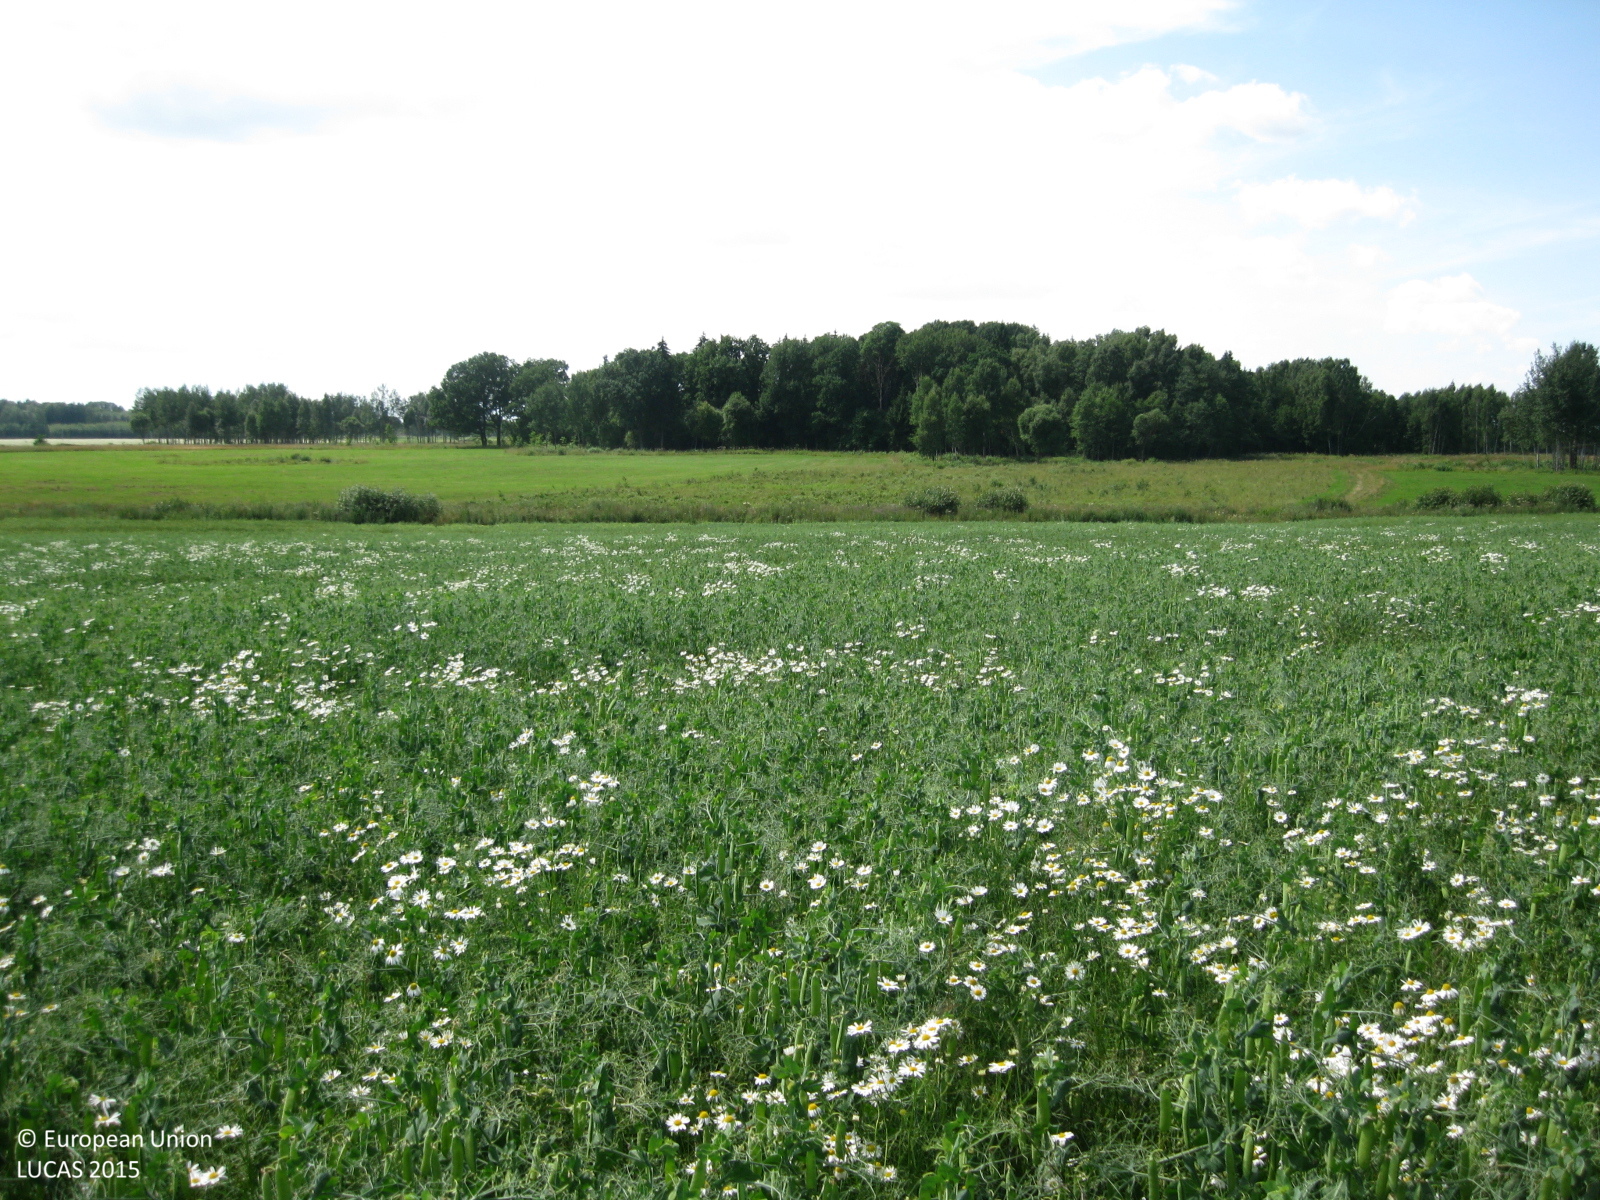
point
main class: Cropland
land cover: Dry pulses
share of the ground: > 75 %
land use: Agriculture (excluding fallow land and kitchen gardens)
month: July
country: LT
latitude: 55.0867
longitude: 24.6275
